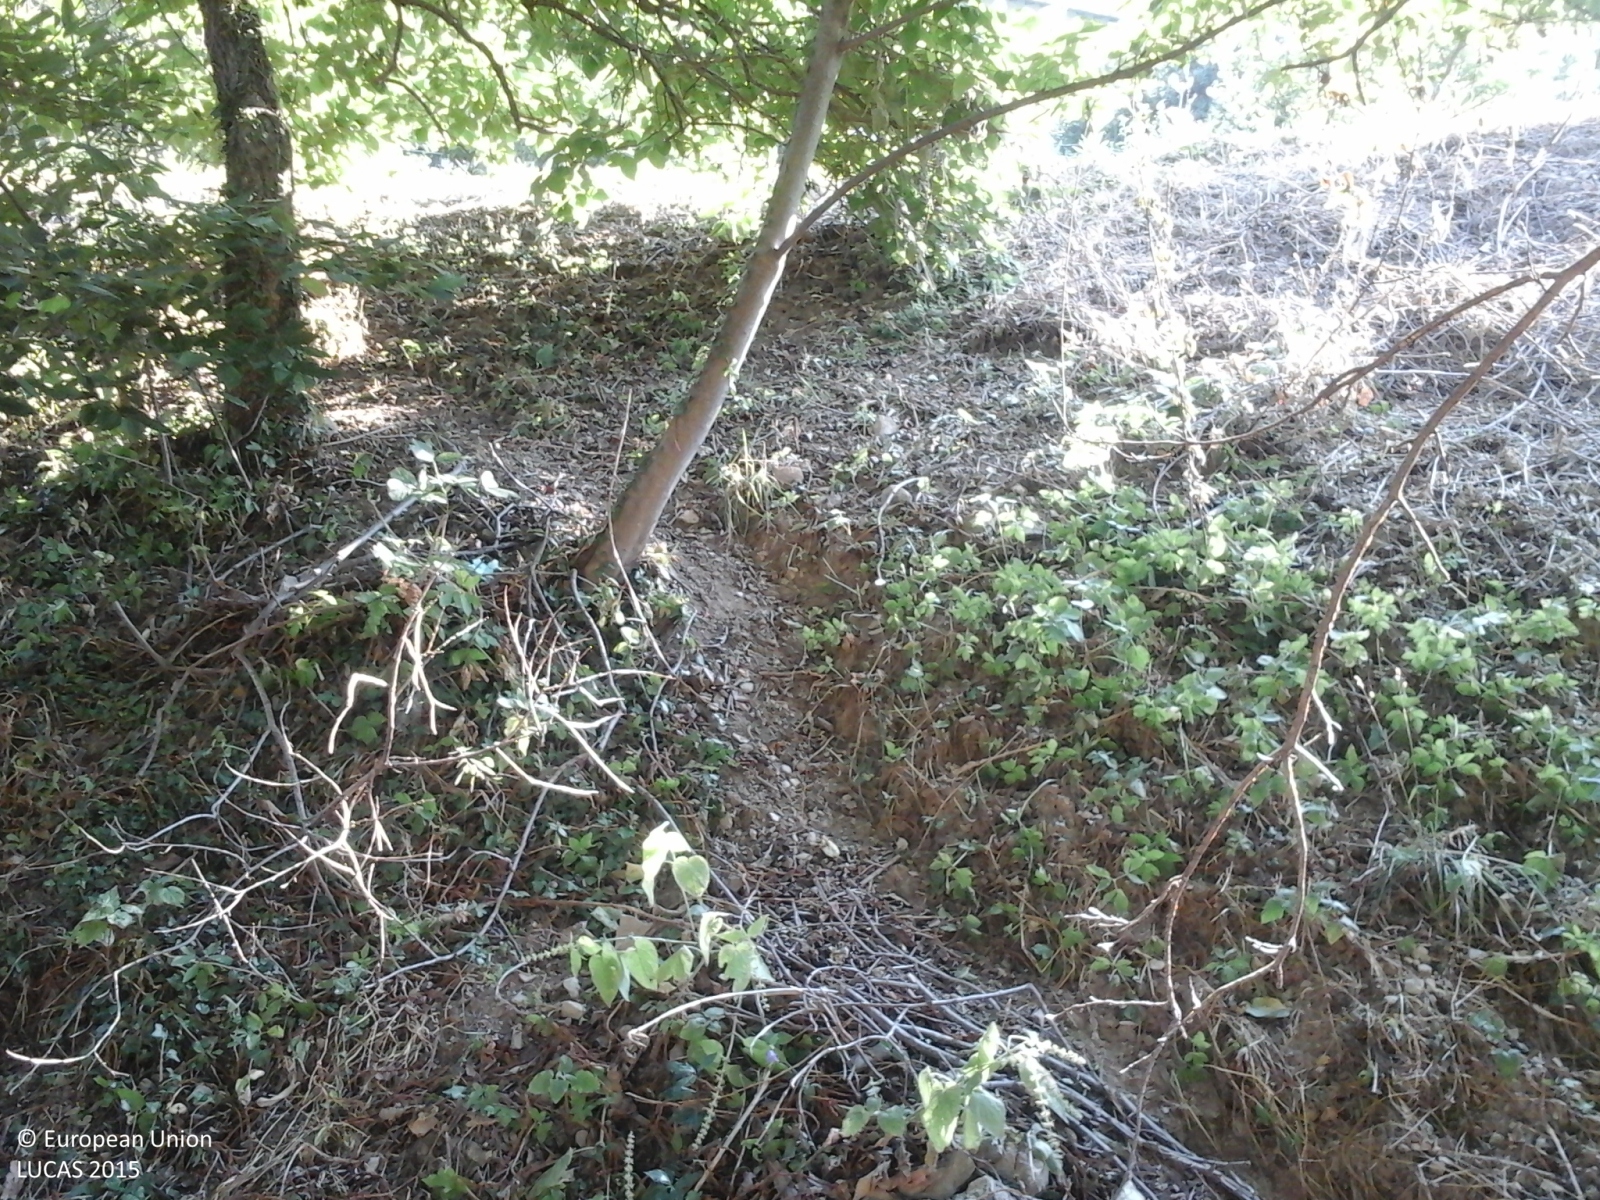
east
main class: Cropland
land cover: Nuts trees
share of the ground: 25 - 50 %
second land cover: Grassland without tree/shrub cover
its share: > 75 %
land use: Agriculture (excluding fallow land and kitchen gardens)
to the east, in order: Nuts trees; Grassland without tree/shrub cover; Artificial constructions in urban areas; Broadleaved woodland; Electric lines; Broadleaved woodland; Paved roads, cycling and walking lanes
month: August
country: IT
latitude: 44.1521
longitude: 8.0665
